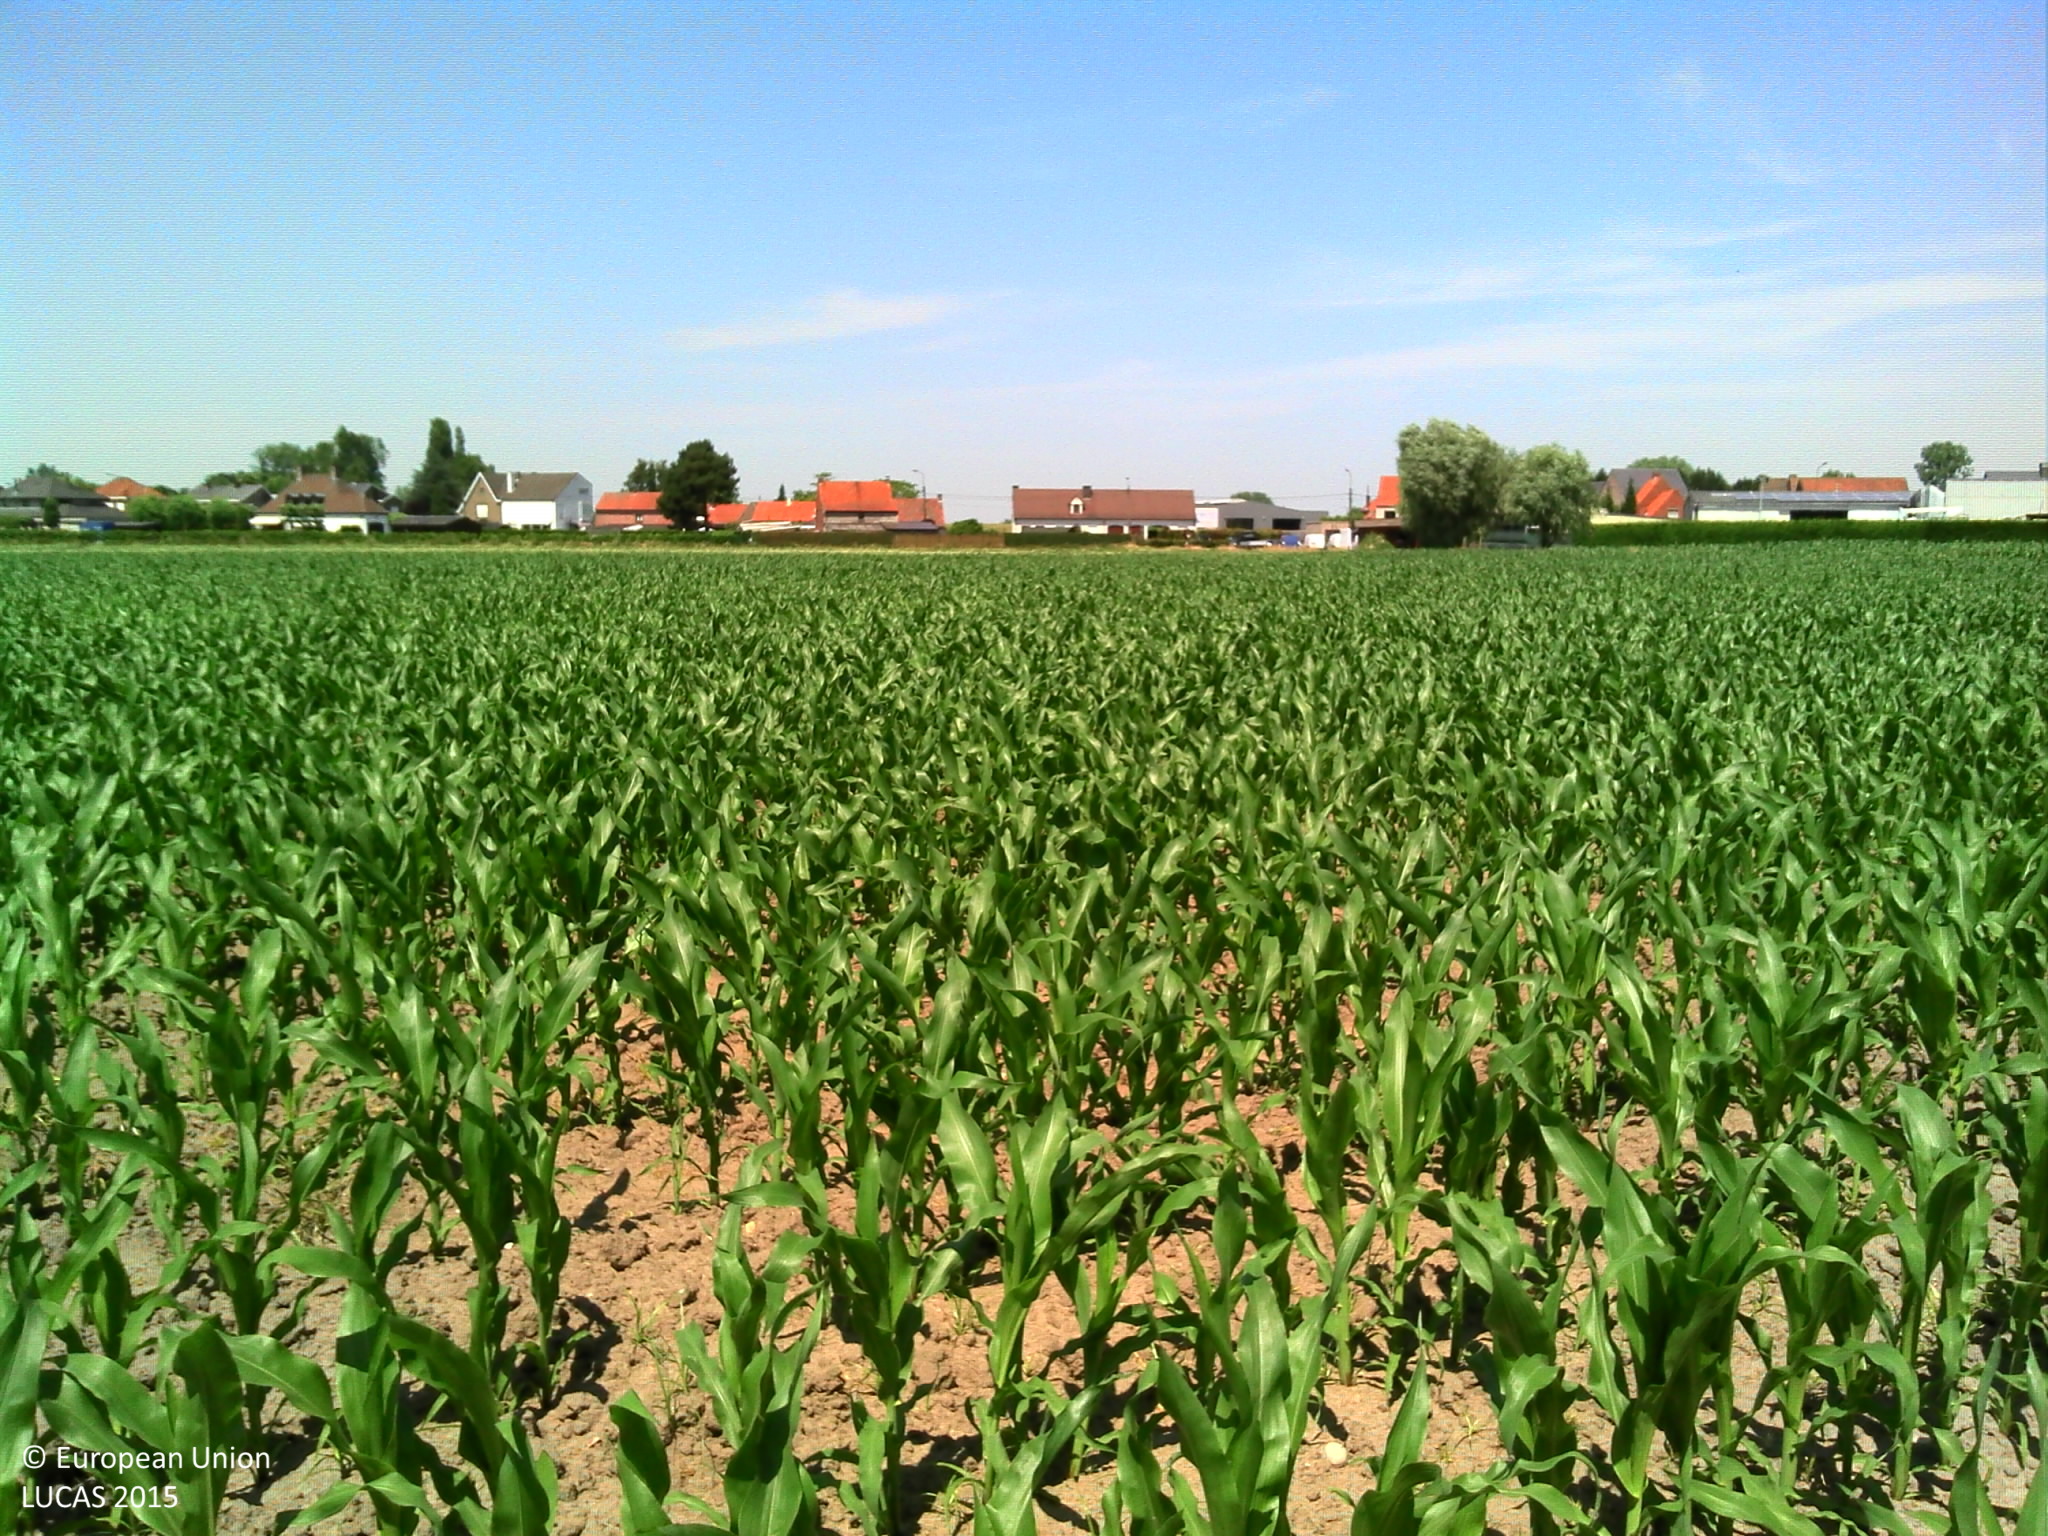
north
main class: Cropland
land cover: Maize
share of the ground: > 75 %
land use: Agriculture (excluding fallow land and kitchen gardens)
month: July
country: BE
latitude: 51.1314
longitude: 3.4327
